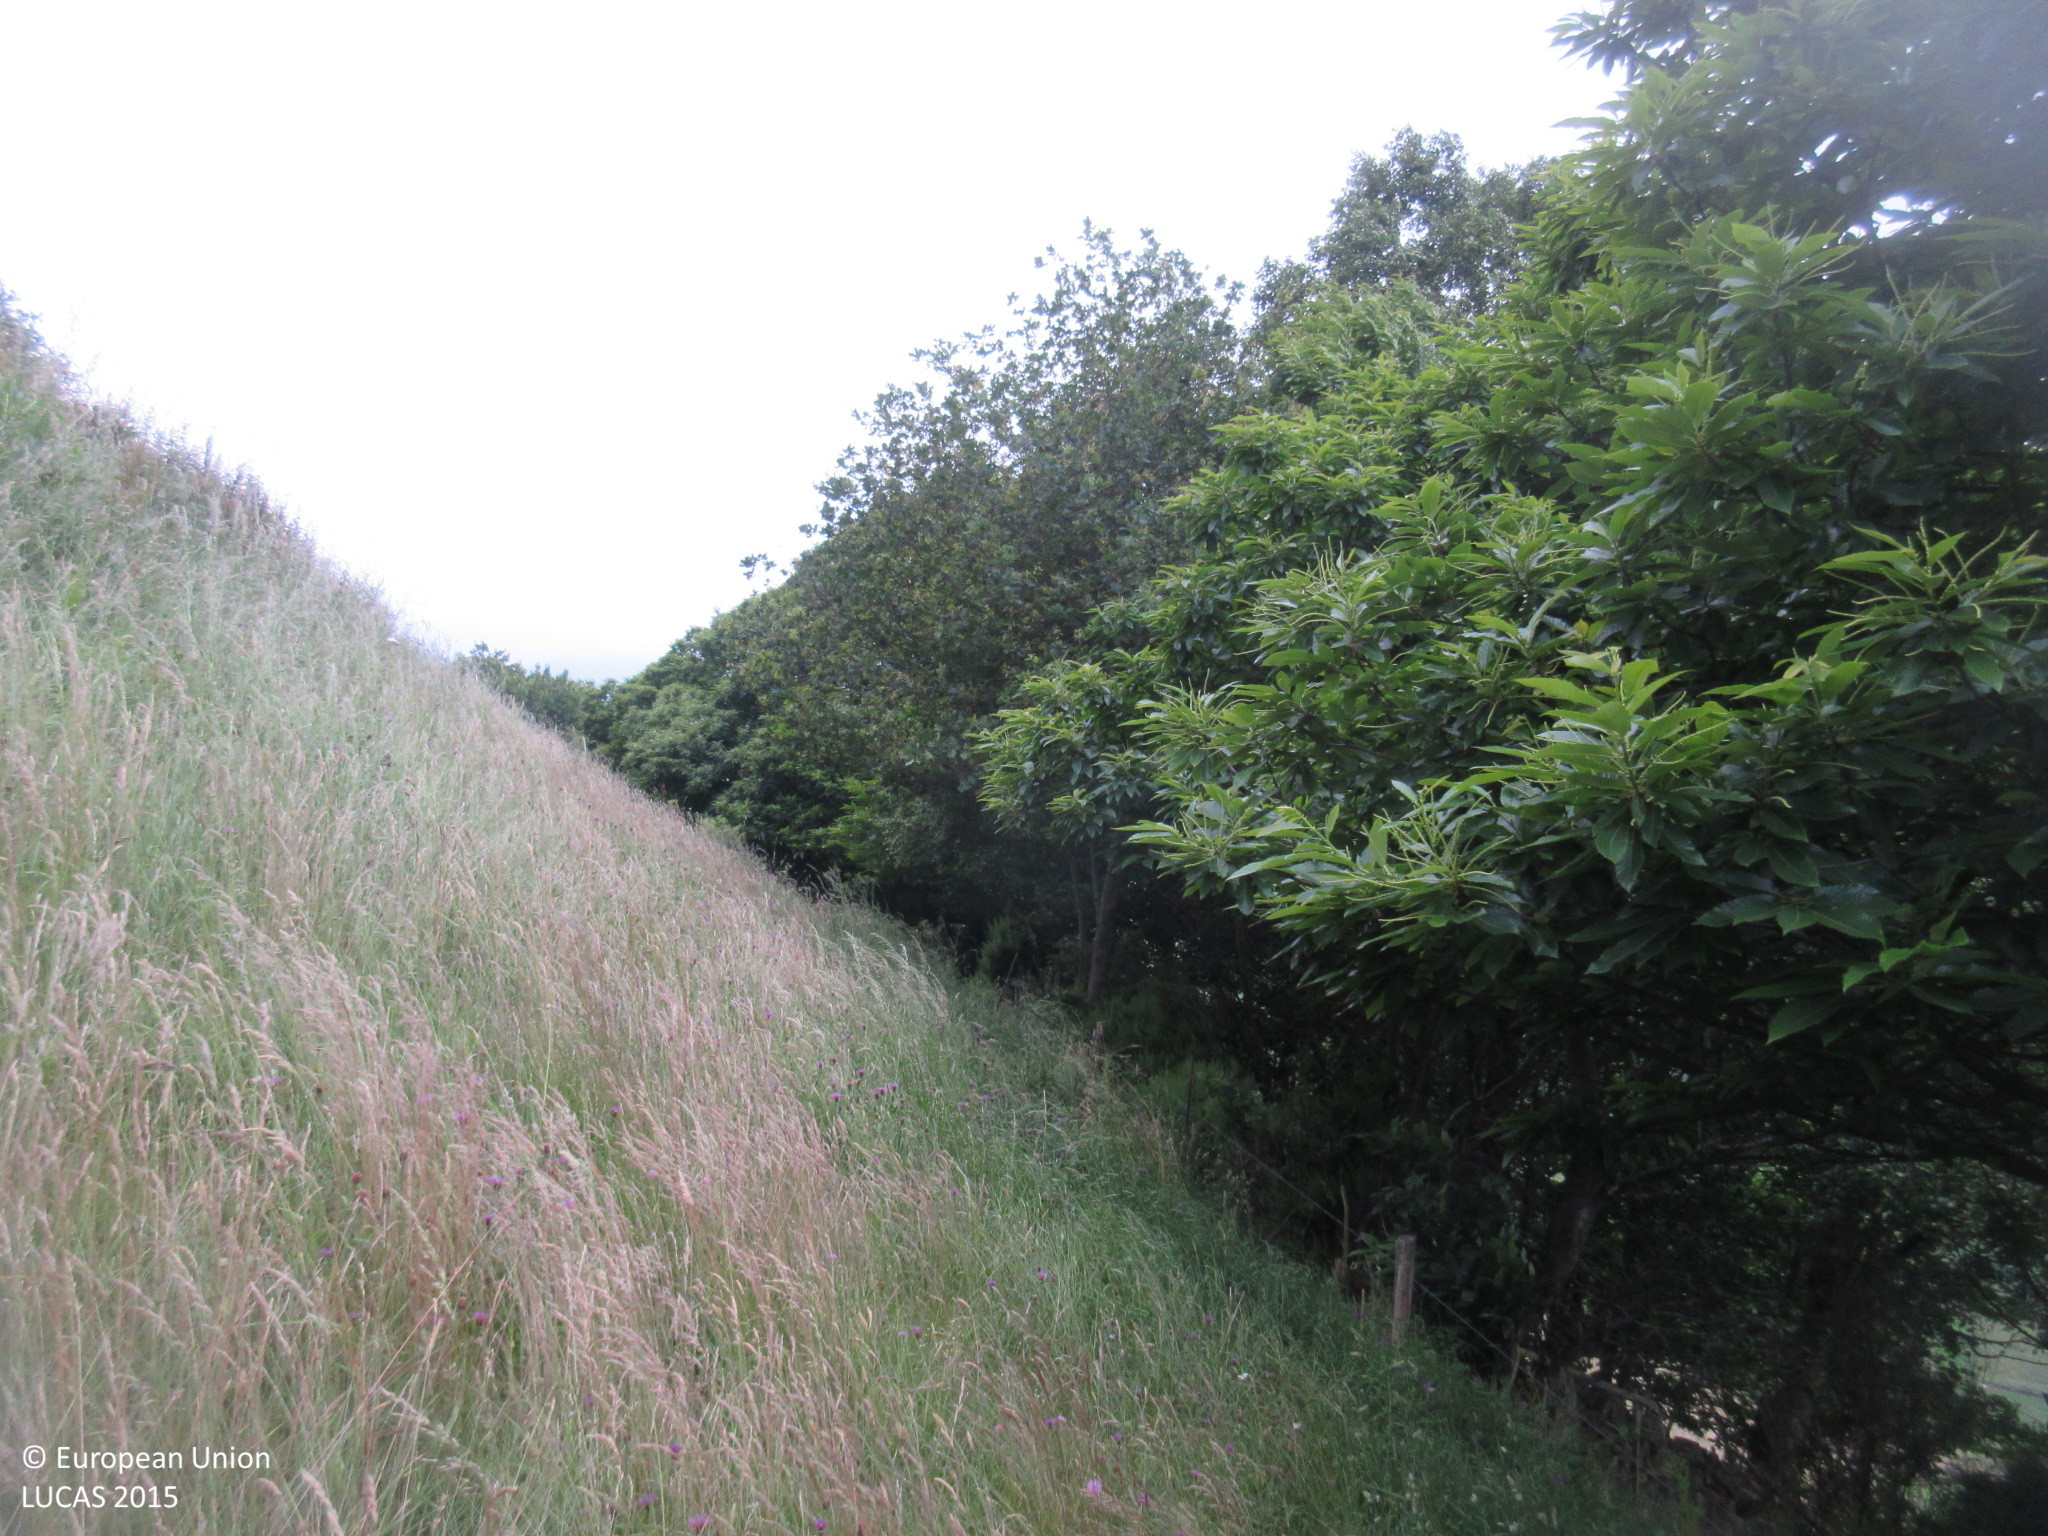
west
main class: Grassland
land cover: Grassland without tree/shrub cover
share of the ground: > 75 %
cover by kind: herbaceous plants 100 %
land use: Agriculture (excluding fallow land and kitchen gardens)
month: June
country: ES
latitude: 43.2815
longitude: -6.3527
